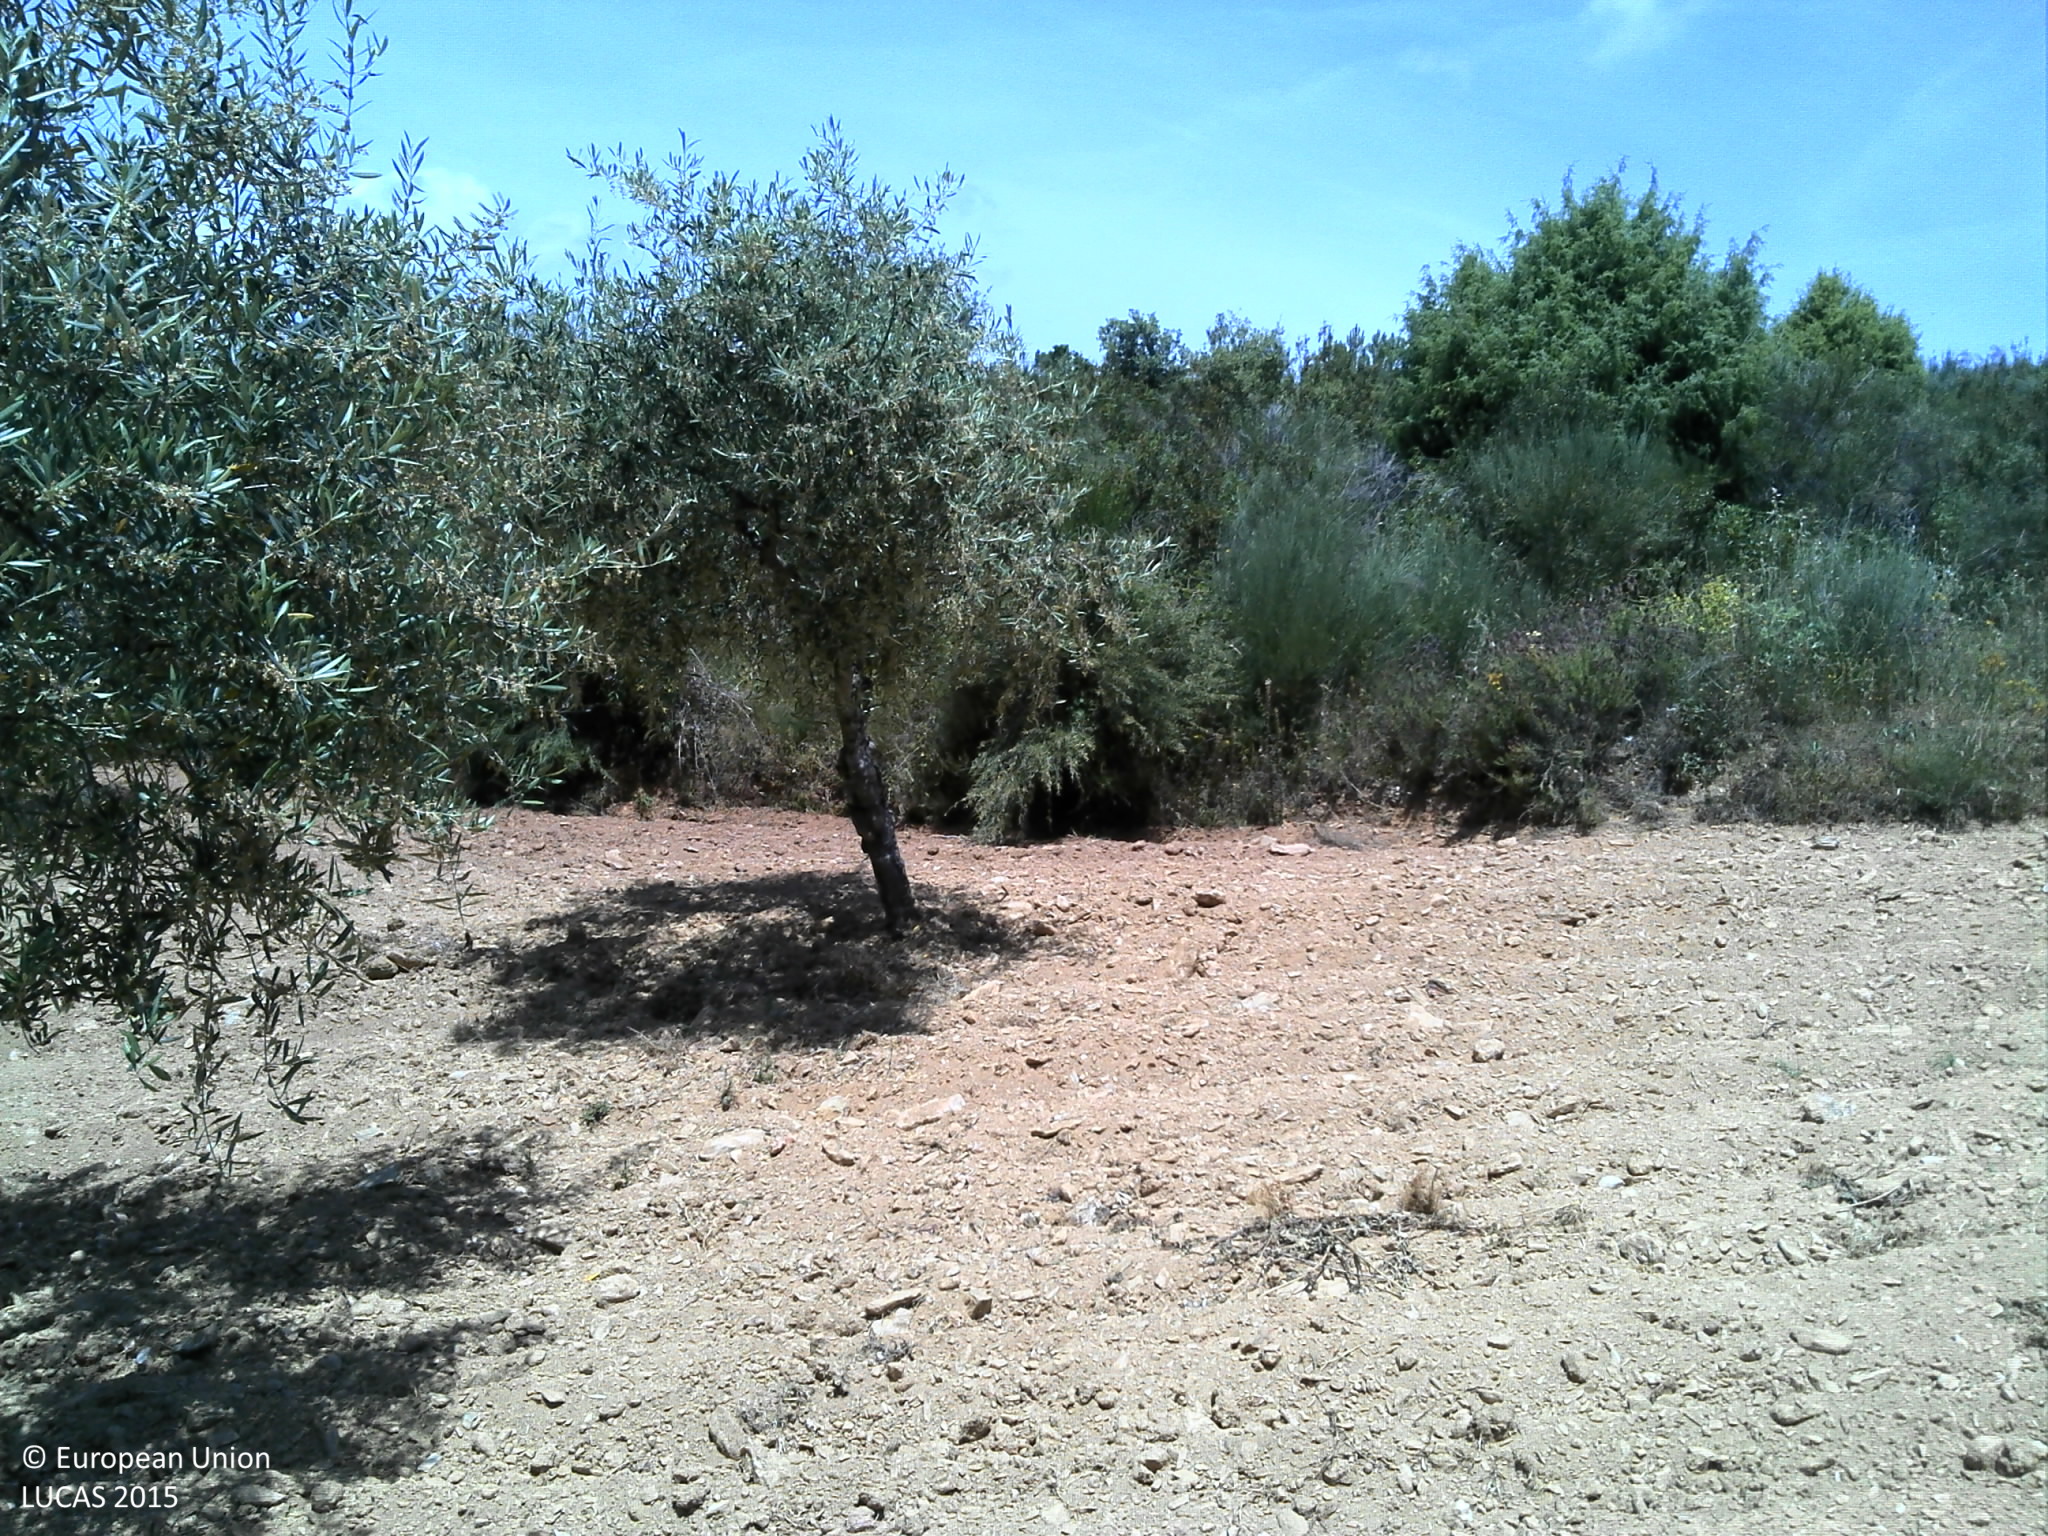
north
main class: Cropland
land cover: Olive groves
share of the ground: 10 - 25 %
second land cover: Other bare soil
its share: > 75 %
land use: Agriculture (excluding fallow land and kitchen gardens)
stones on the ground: 25 - 50 %
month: June
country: PT
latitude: 41.3583
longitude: -6.8557
